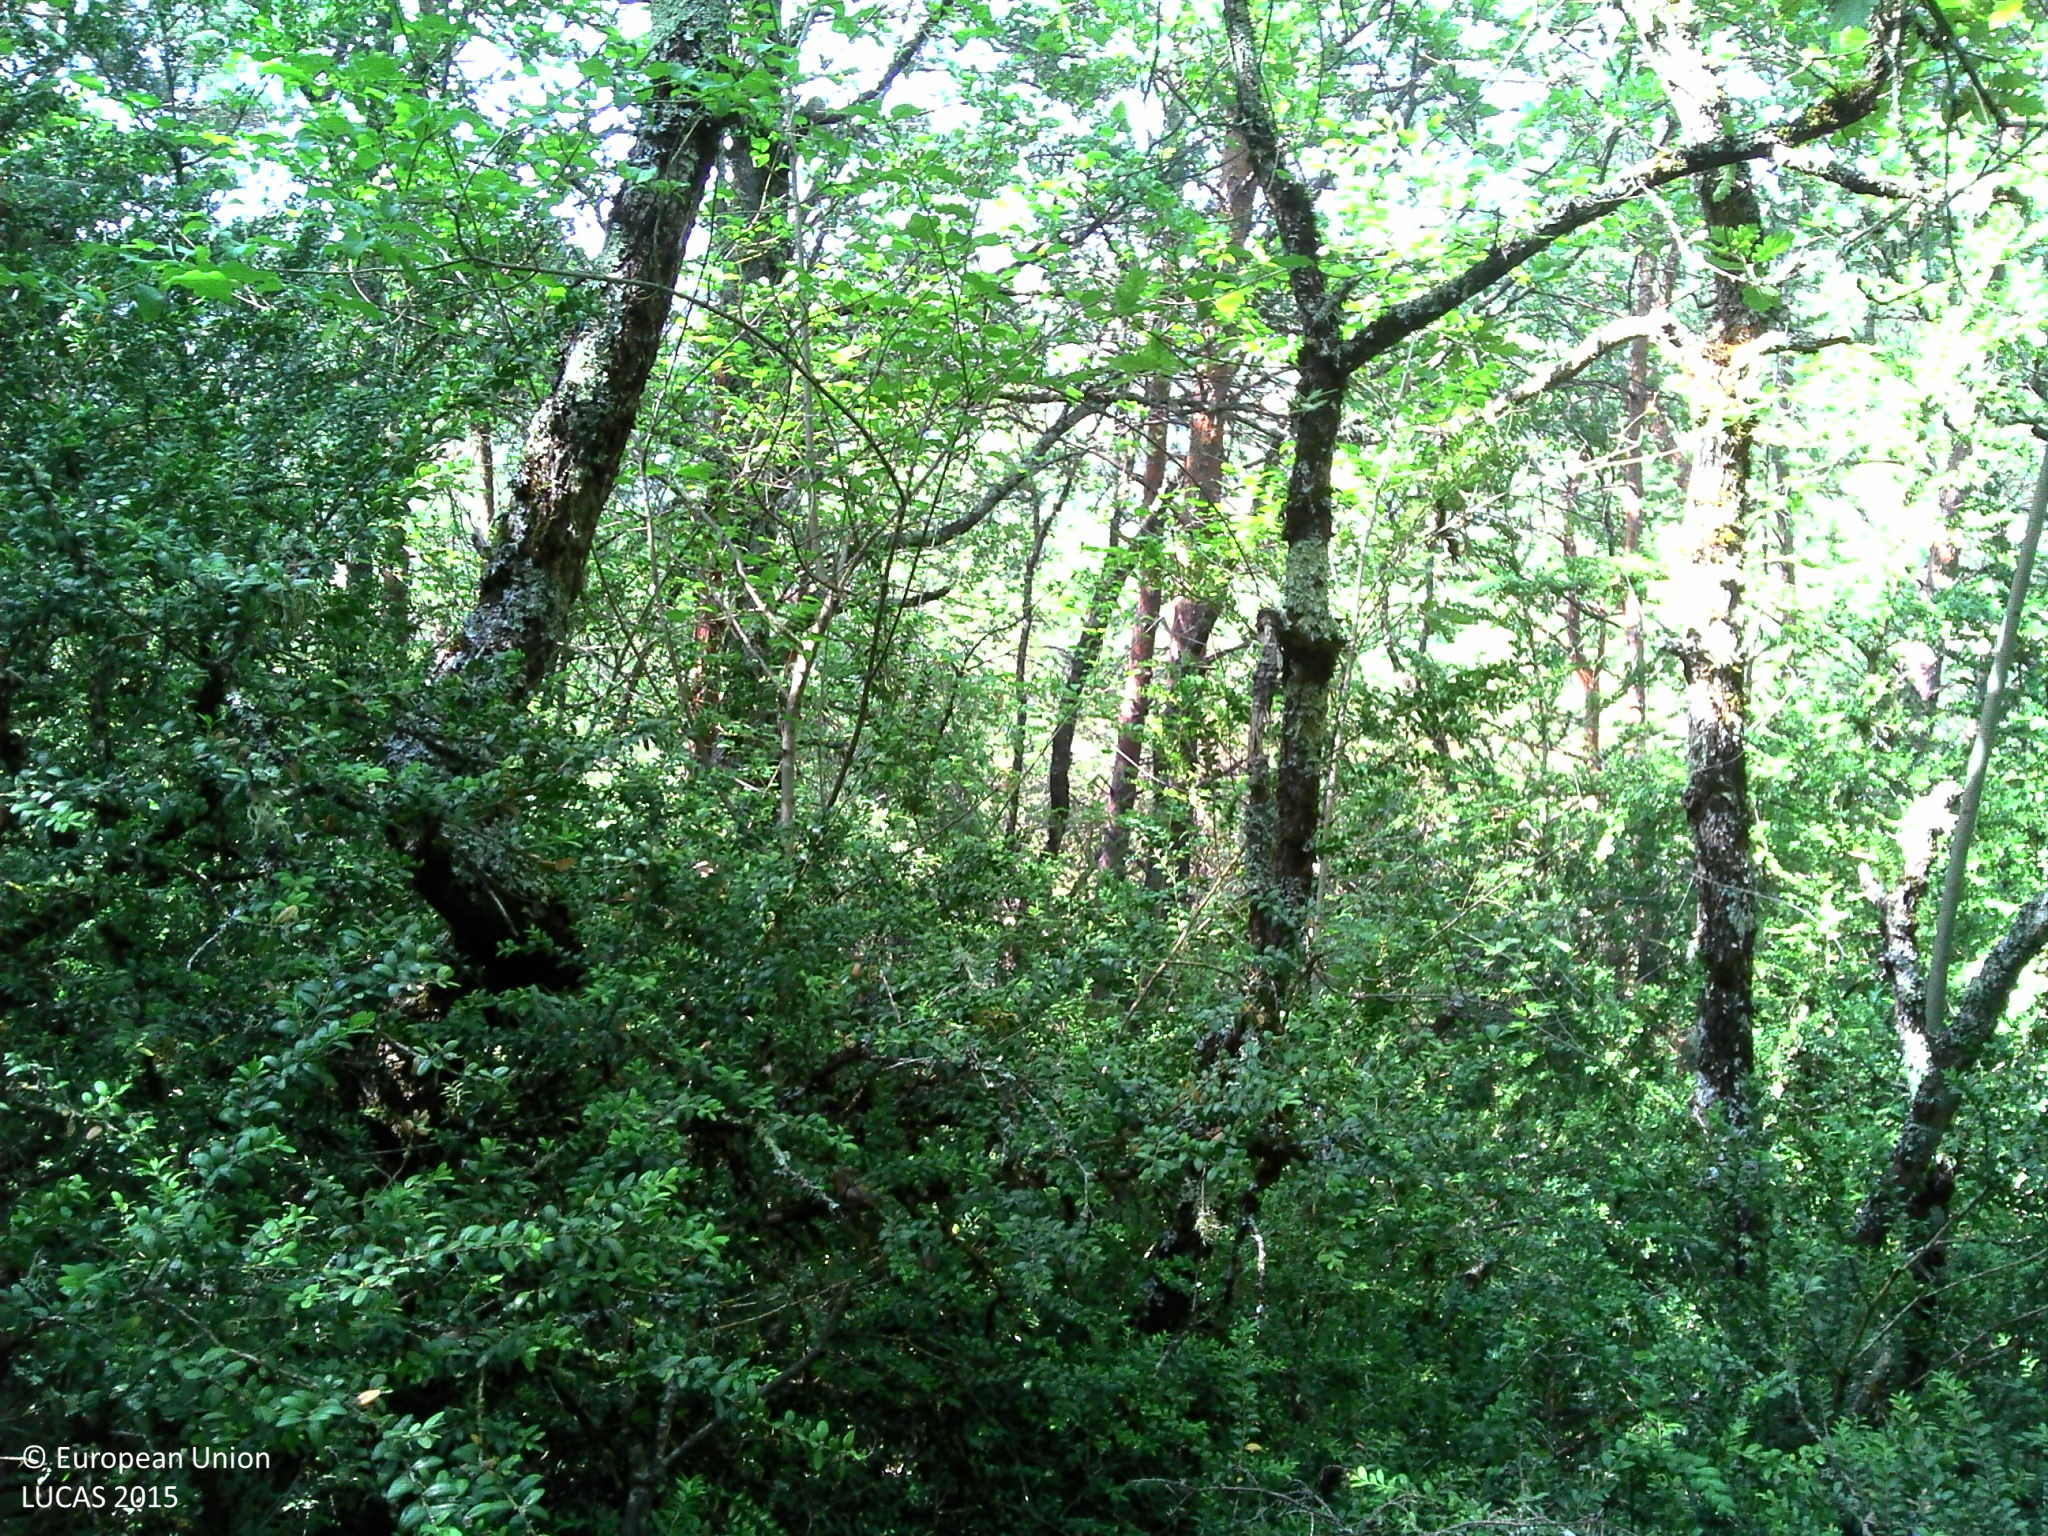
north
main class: Woodland
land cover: Pine dominated mixed woodland
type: coniferous forest of the mediterranean region
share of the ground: > 75 %
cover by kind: coniferous forest trees 40 %, broadleaved forest trees 40 %, shrubs 15 %, herbaceous plants 5 %
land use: Semi-natural and natural areas not in use
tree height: > 5 m
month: July
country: FR
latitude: 43.8426
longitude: 5.6180
